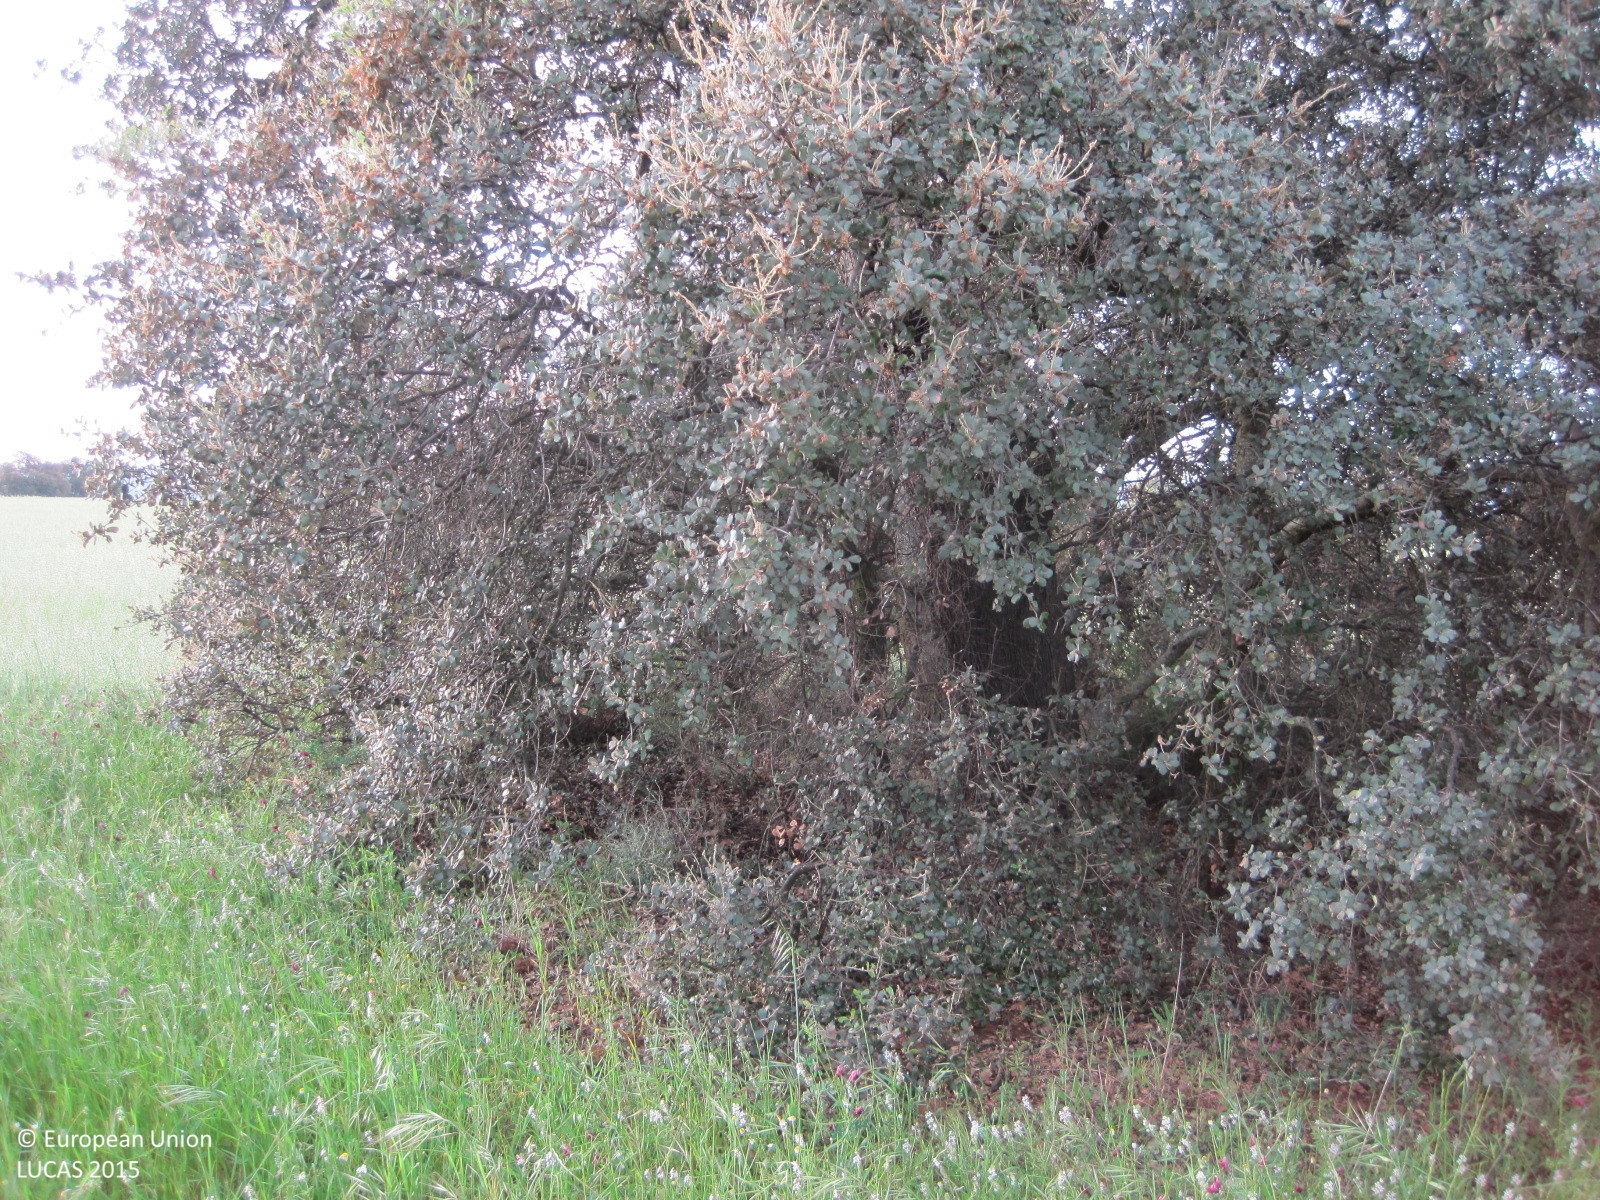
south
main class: Cropland
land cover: Oats
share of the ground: > 75 %
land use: Agriculture (excluding fallow land and kitchen gardens)
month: May
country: ES
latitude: 39.8347
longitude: -4.6851
